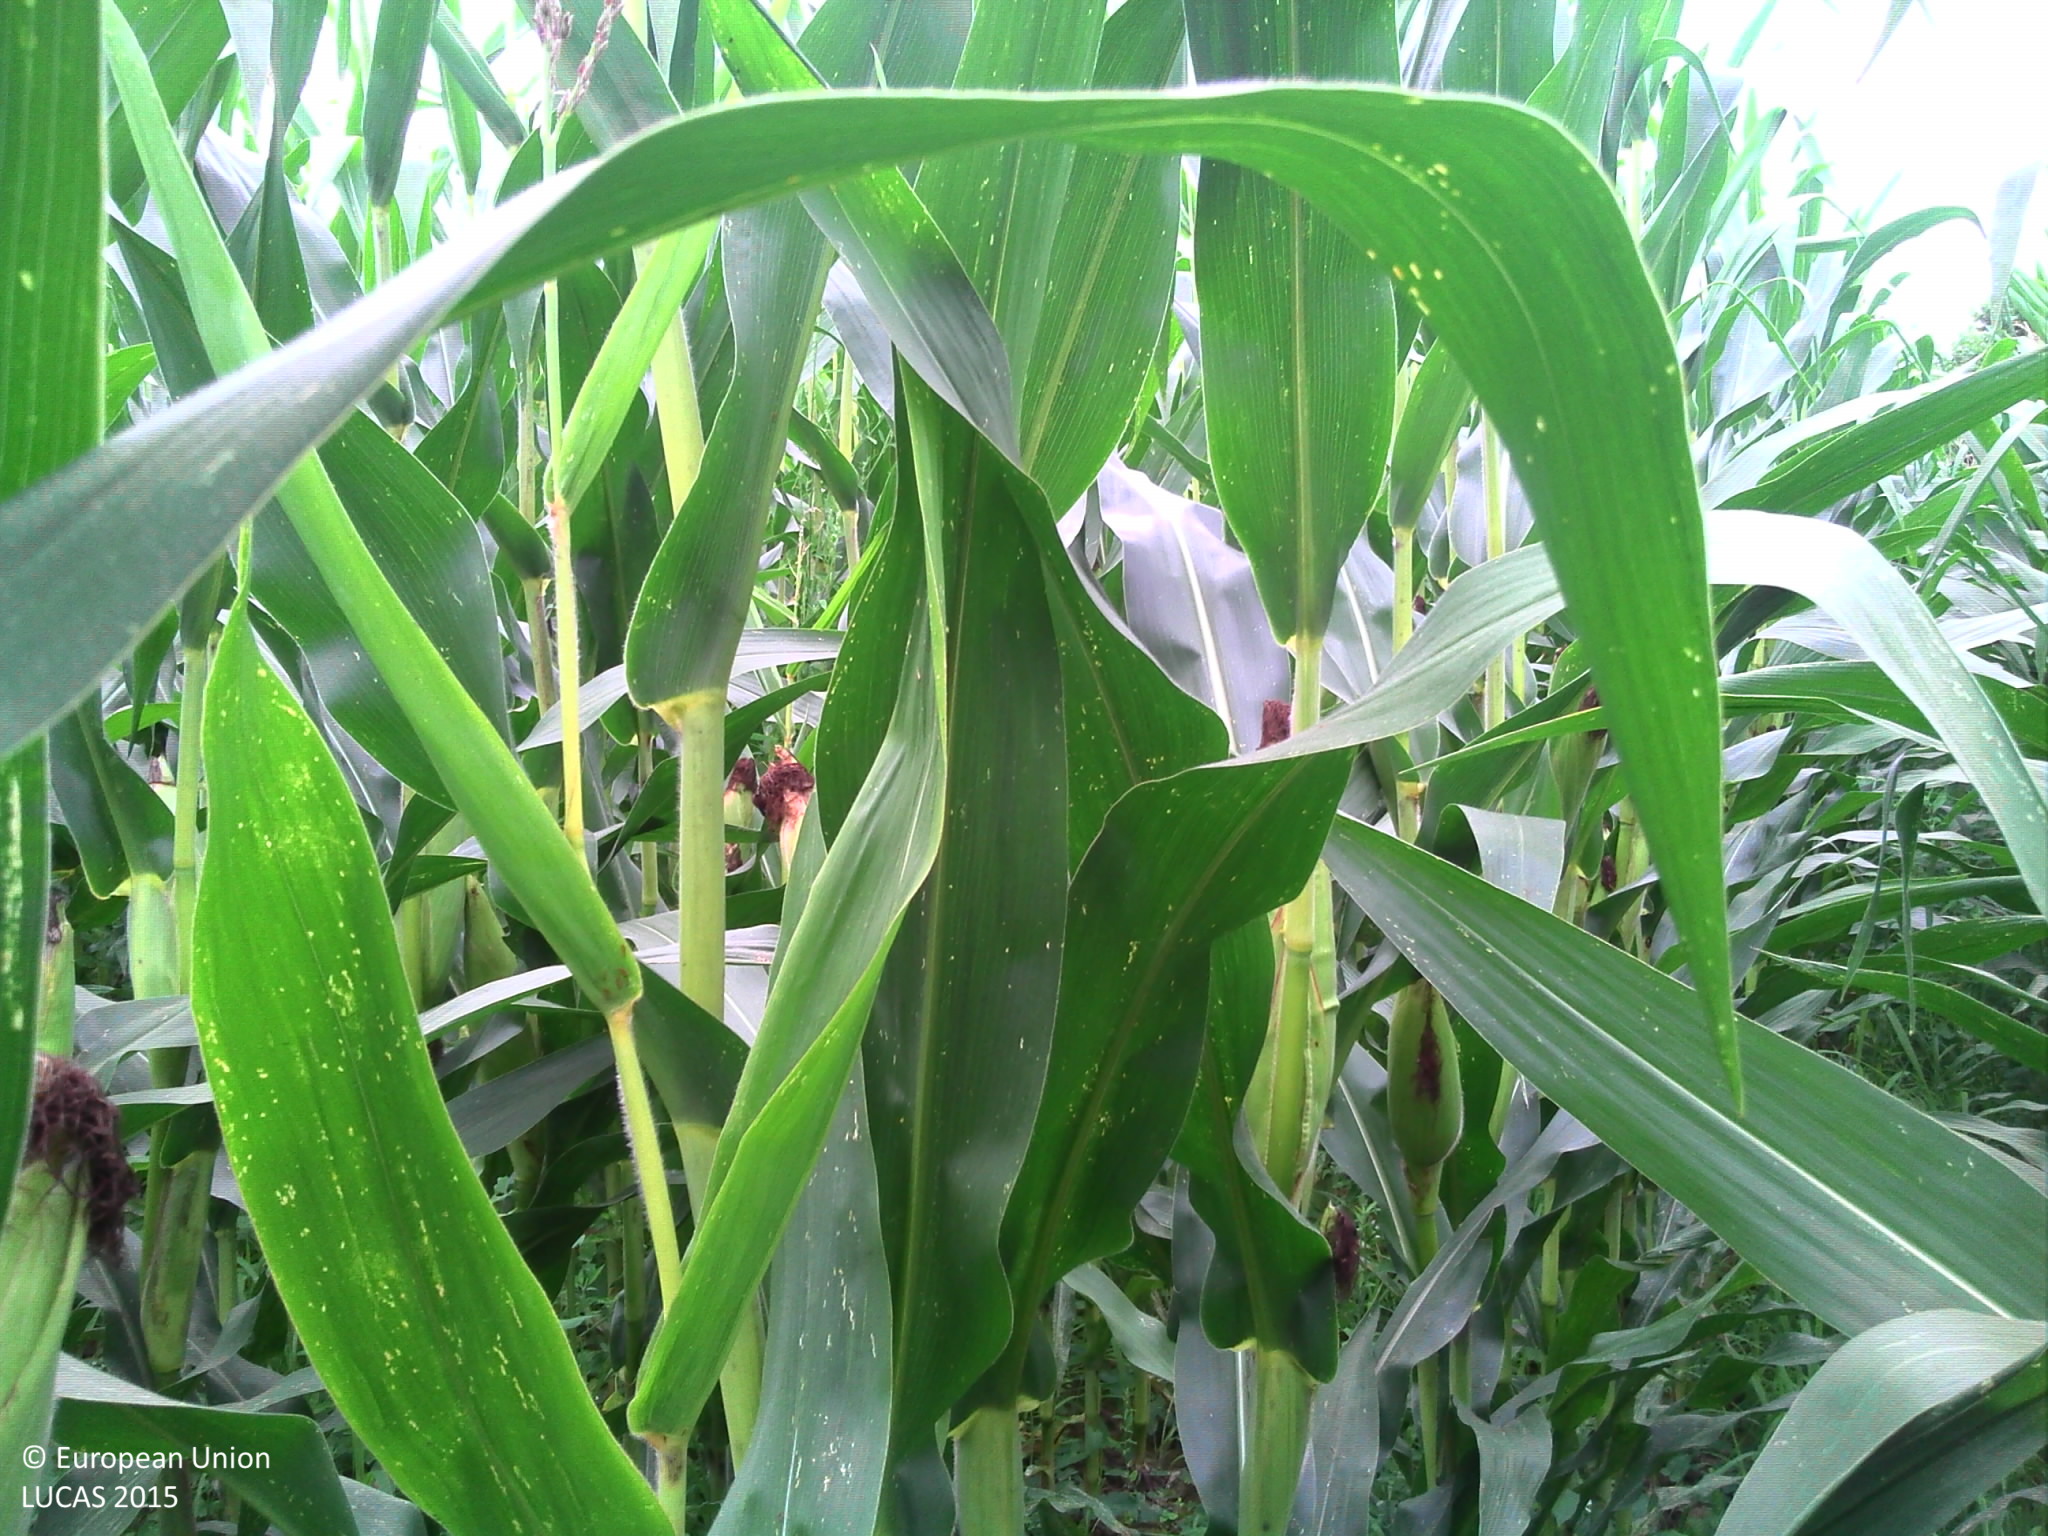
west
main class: Cropland
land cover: Maize
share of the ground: > 75 %
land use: Agriculture (excluding fallow land and kitchen gardens)
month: August
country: FR
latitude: 43.5127
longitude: -1.1357
